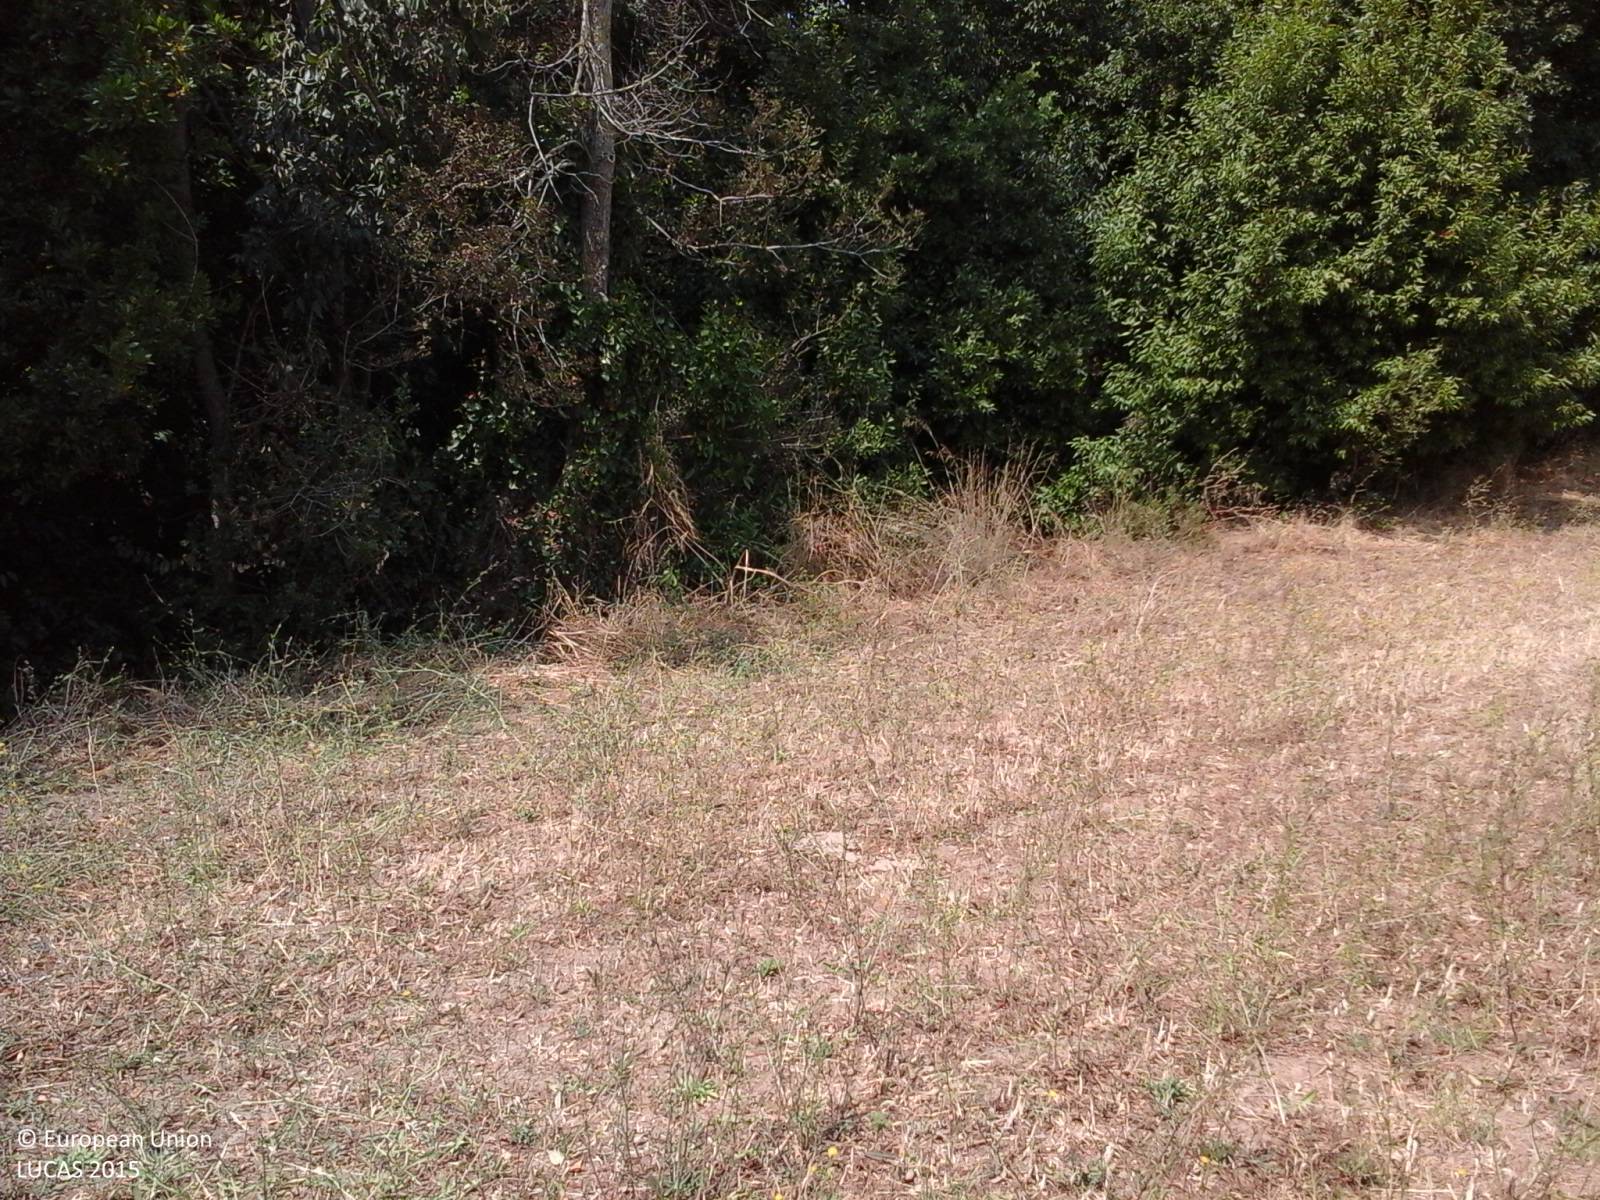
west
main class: Cropland
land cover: Mixed cereals for fodder
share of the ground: > 75 %
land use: Agriculture (excluding fallow land and kitchen gardens)
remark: Harvested field
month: July
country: IT
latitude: 41.9790
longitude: 12.2245
